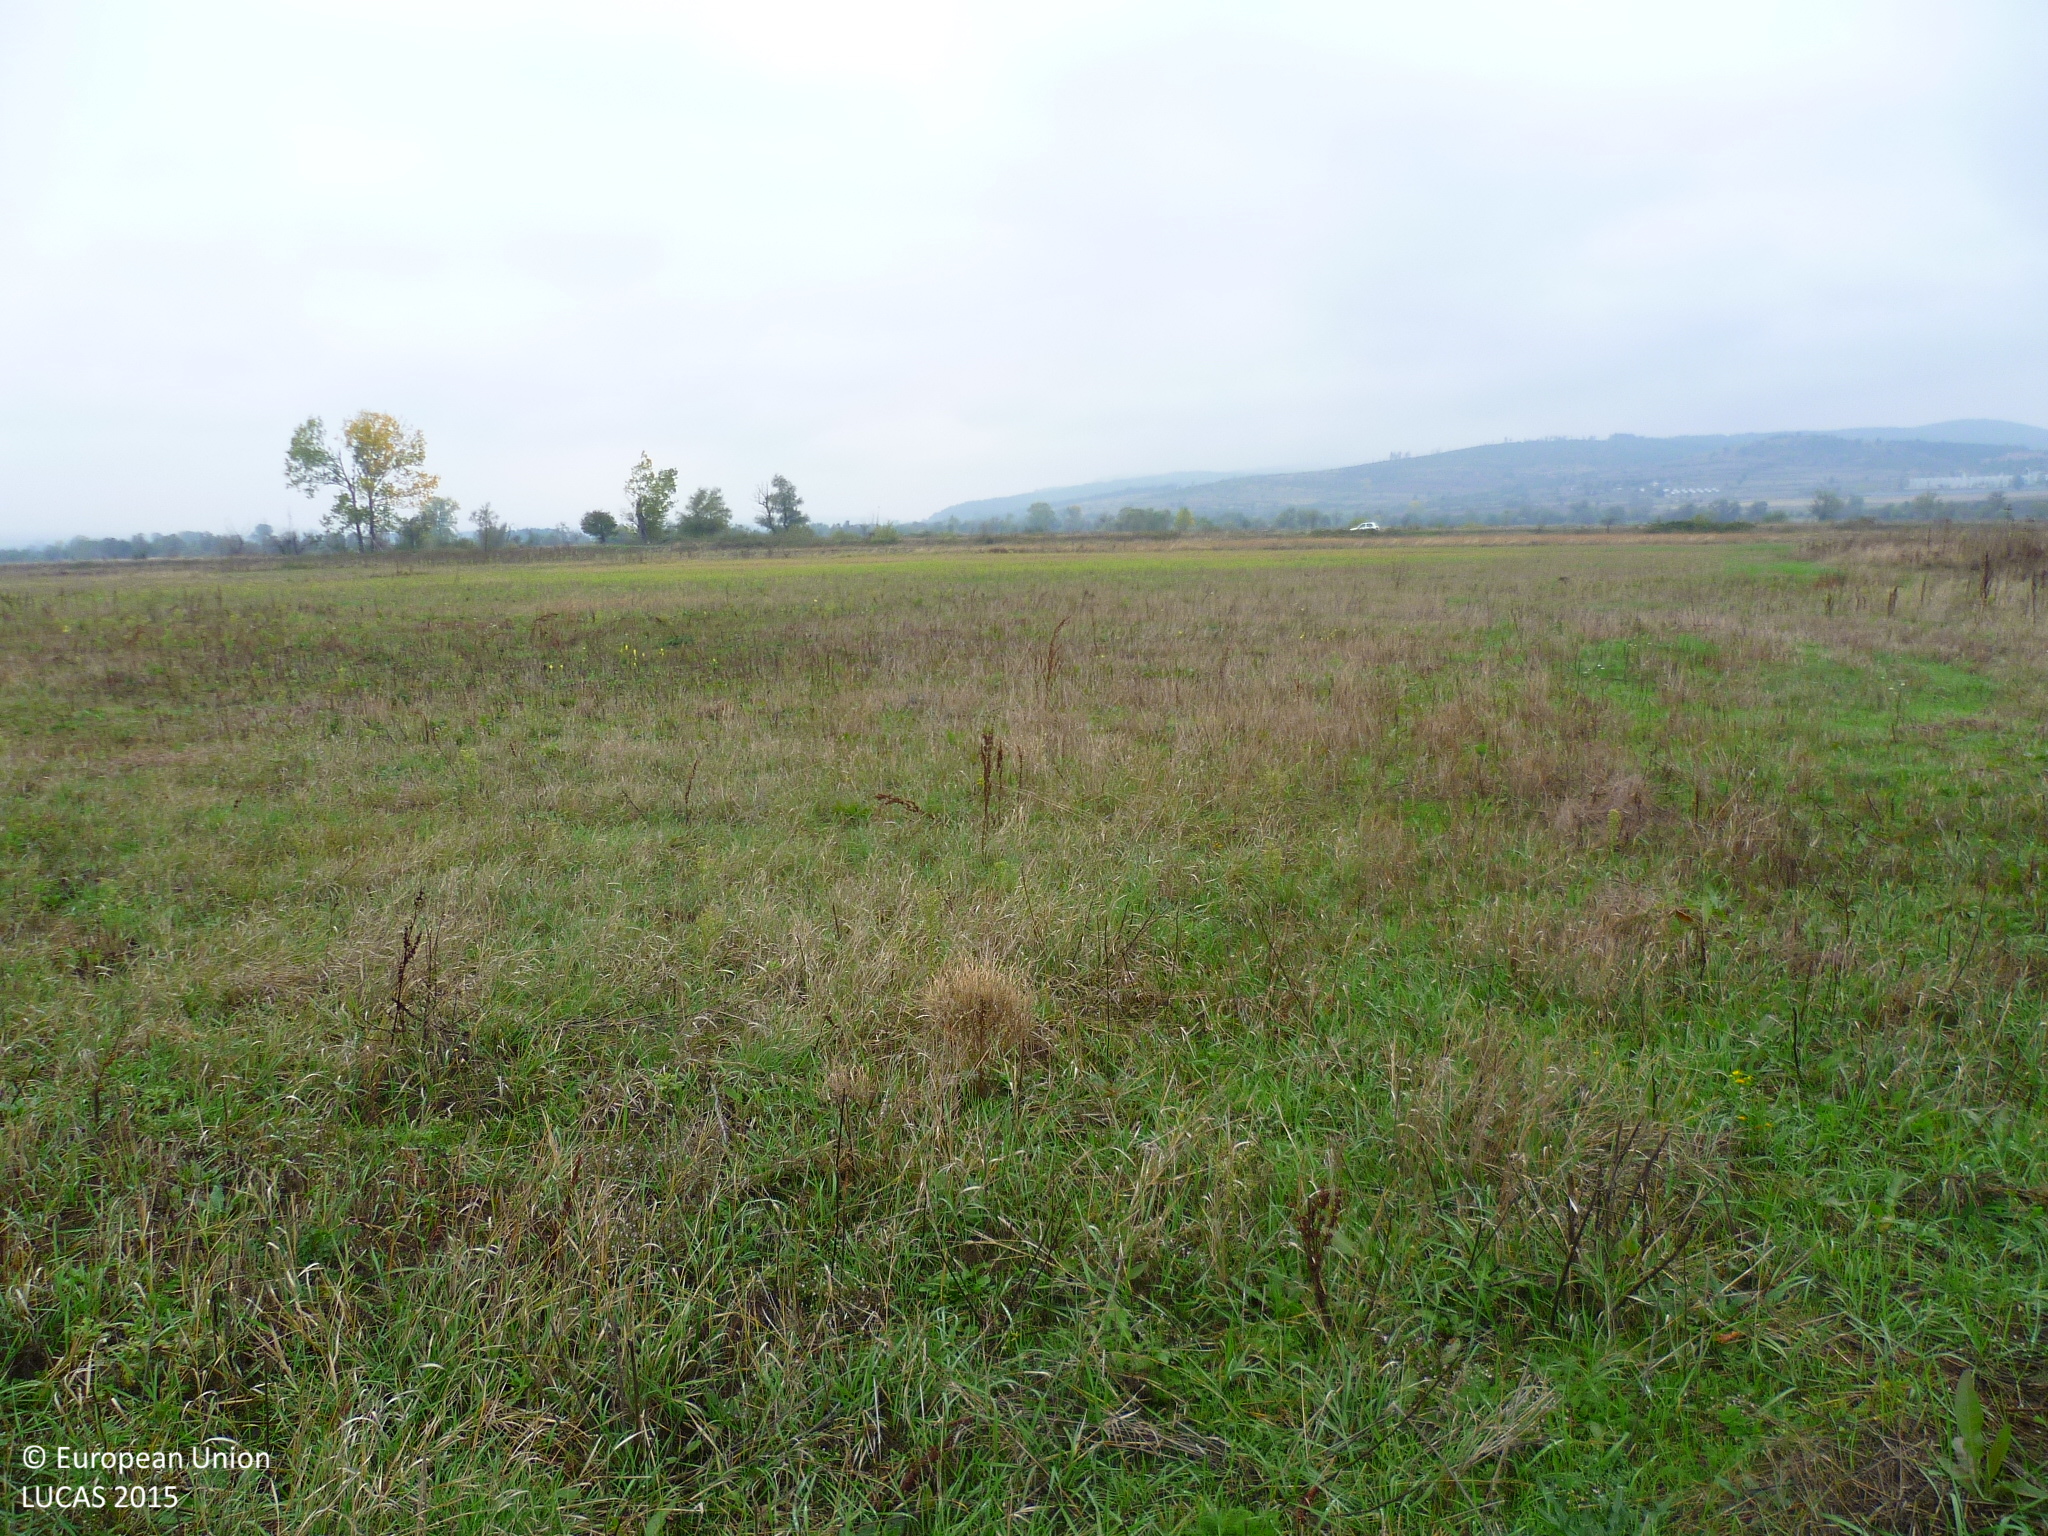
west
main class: Grassland
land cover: Grassland without tree/shrub cover
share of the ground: > 75 %
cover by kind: herbaceous plants 100 %
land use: Agriculture (excluding fallow land and kitchen gardens)
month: October
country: BG
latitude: 42.3248
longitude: 23.8107
